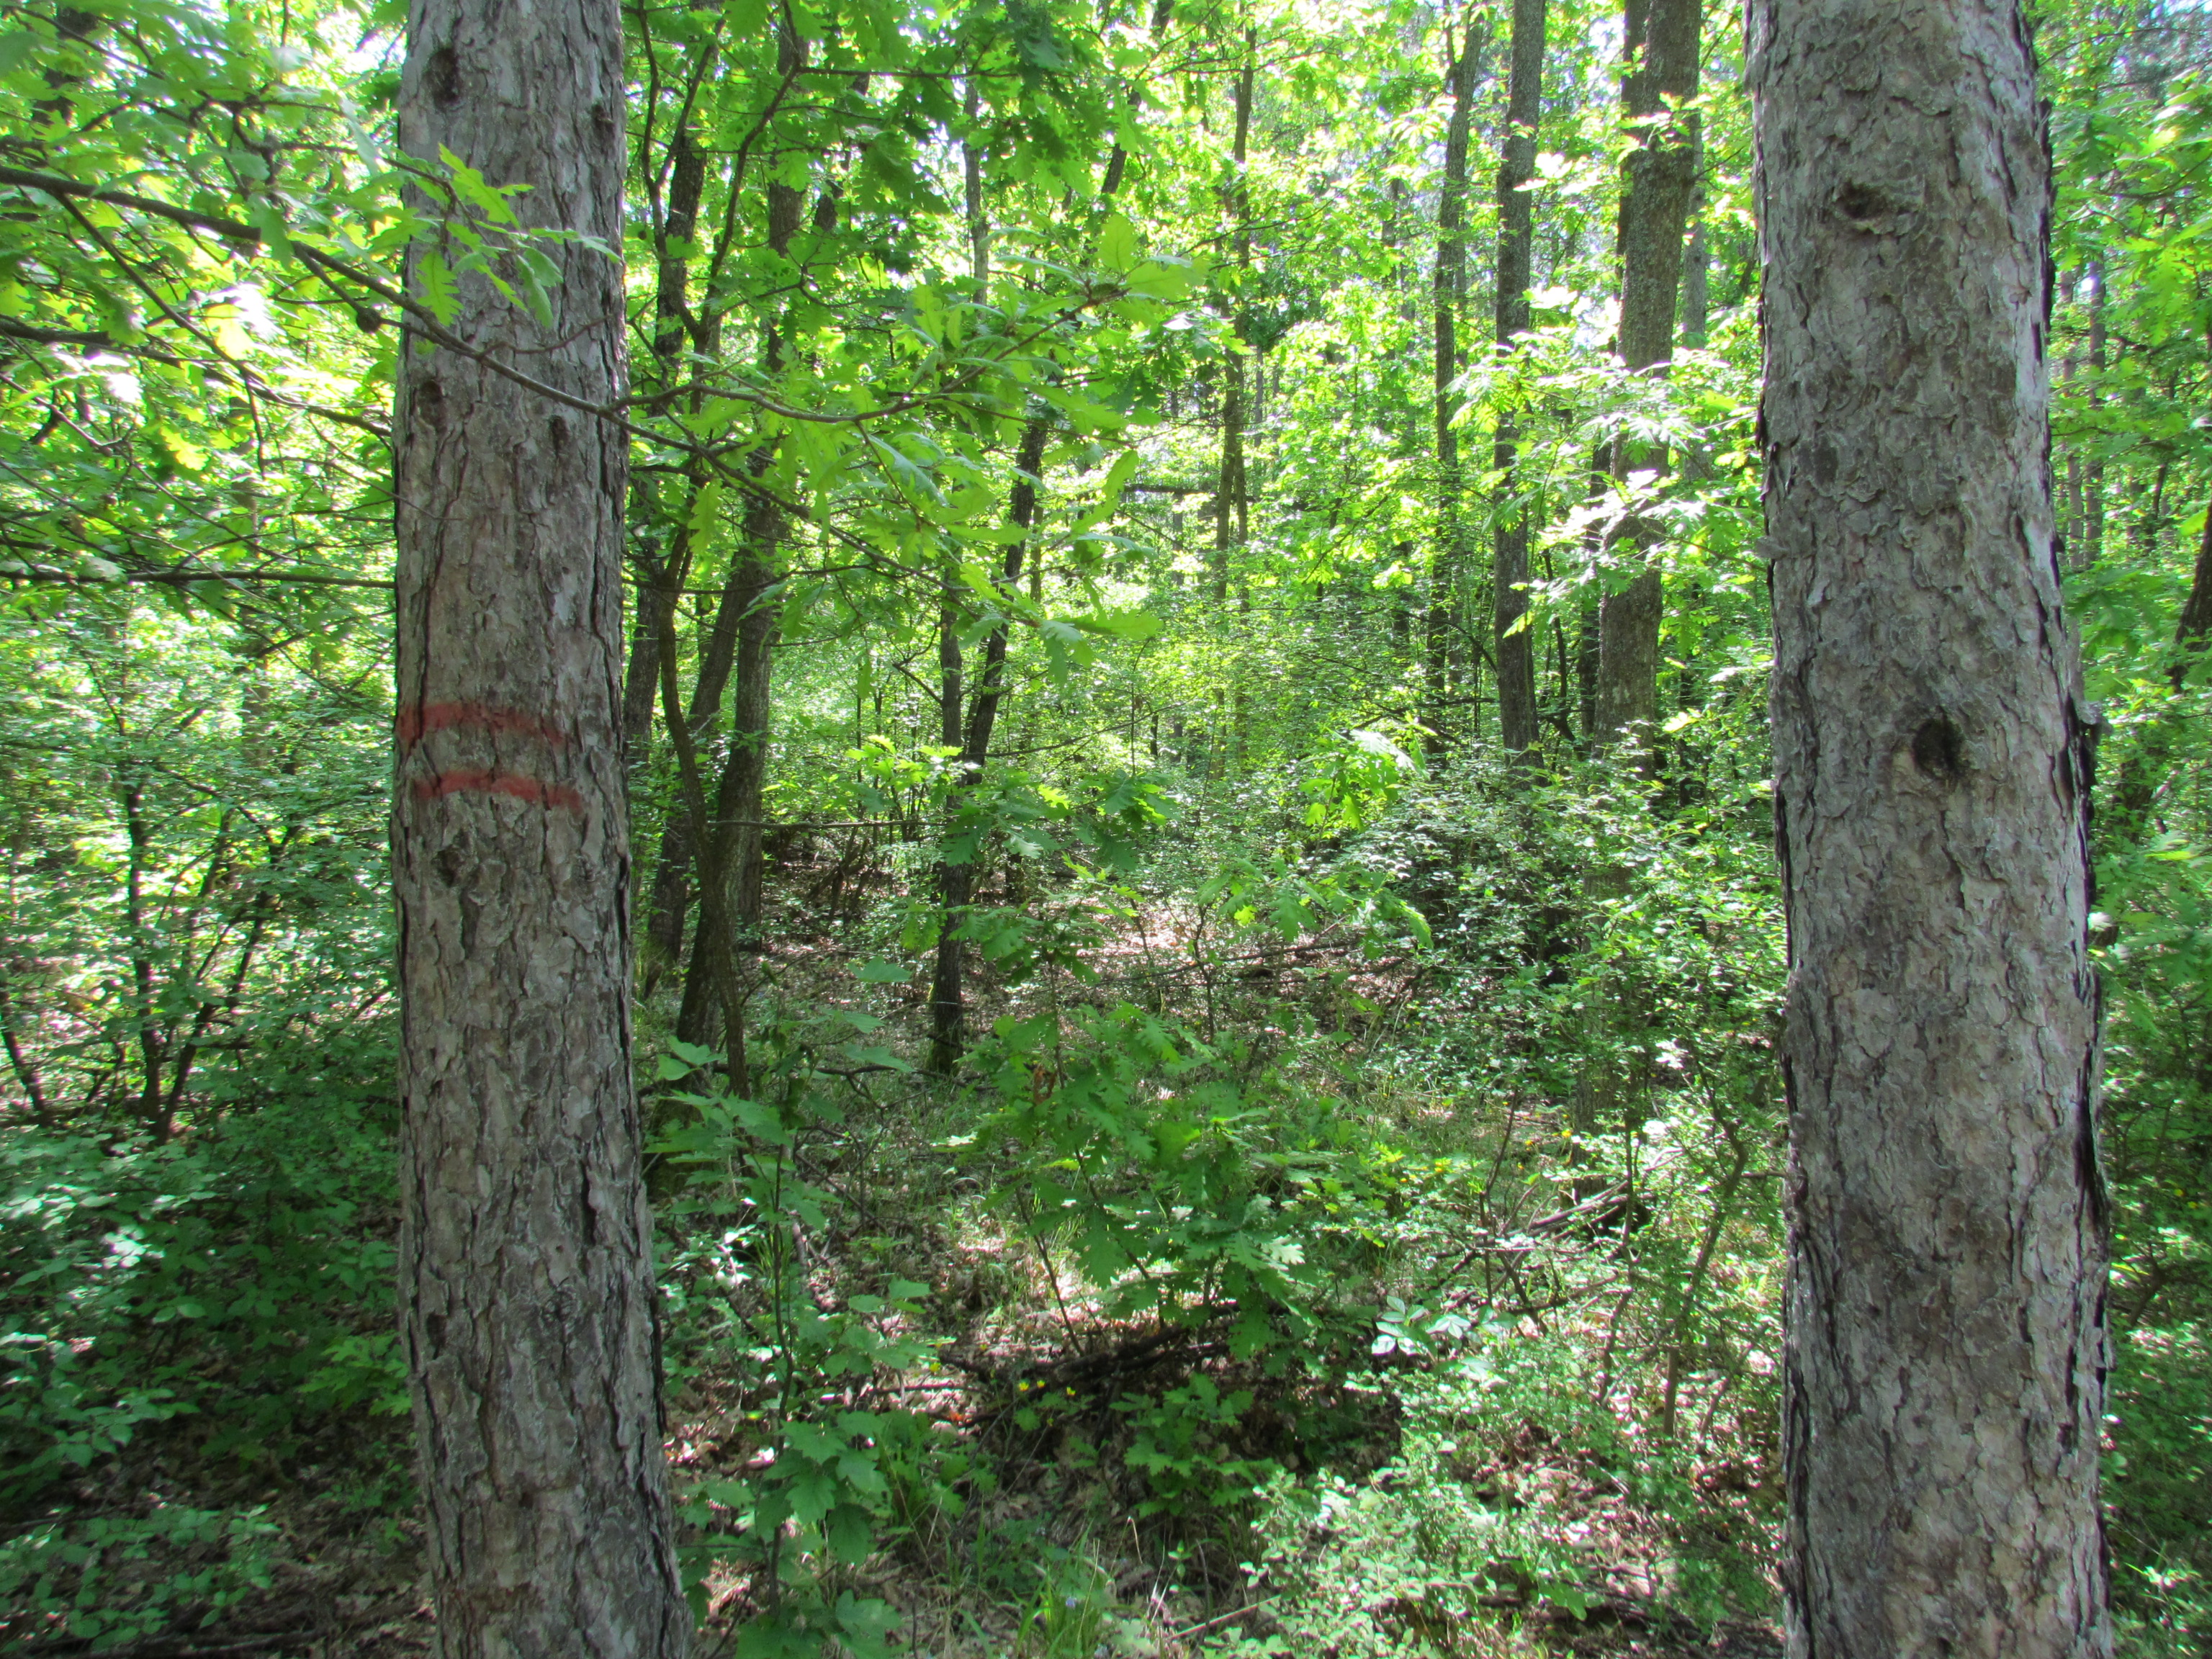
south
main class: Woodland
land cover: Pine dominated mixed woodland
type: hemiboreal forest and nemoral coniferous forest and mixed broadleaved-coniferous forest
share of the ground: > 75 %
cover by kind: broadleaved forest trees 75 %, coniferous forest trees 25 %
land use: Forestry
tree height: > 5 m
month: May
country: BG
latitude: 42.2321
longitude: 27.1286
